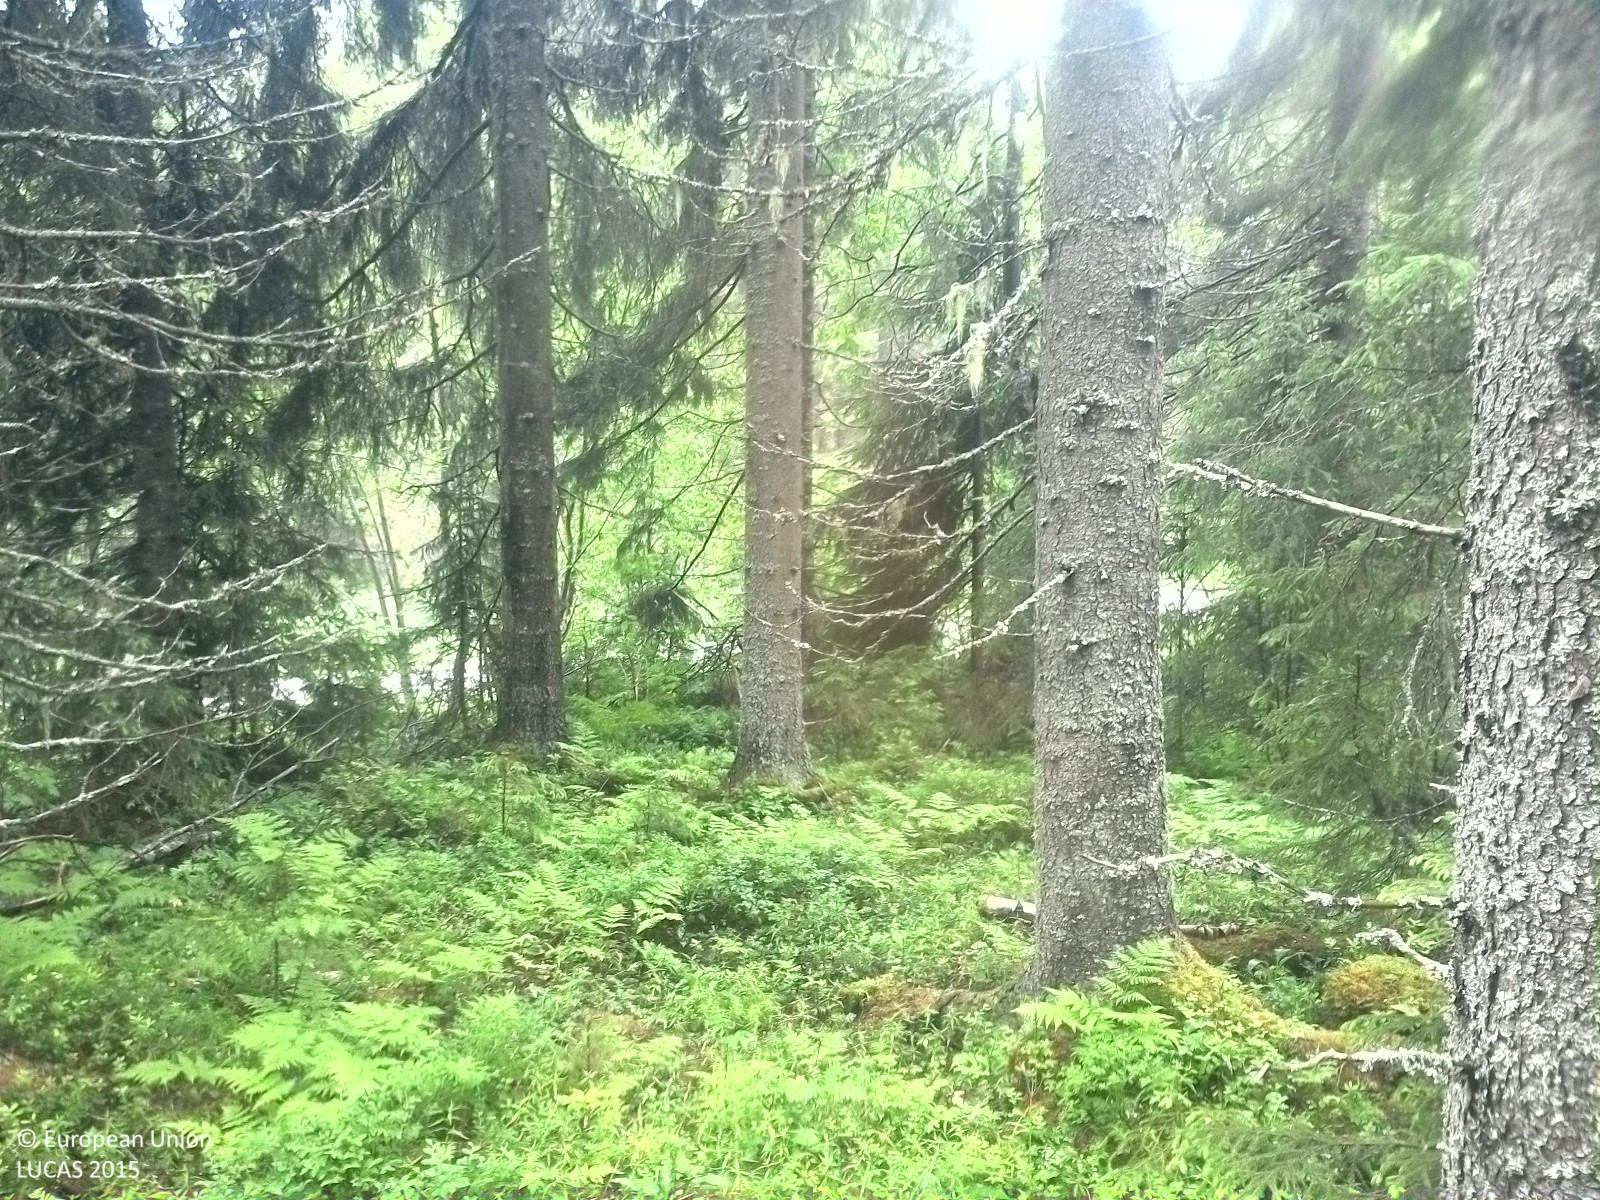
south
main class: Woodland
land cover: Spruce dominated mixed woodland
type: boreal forest
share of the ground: 50 - 75 %
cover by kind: coniferous forest trees 40 %, herbaceous plants 30 %, broadleaved forest trees 20 %, lichens and mosses 10 %
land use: Forestry
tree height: > 5 m
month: July
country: SE
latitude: 62.4756
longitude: 16.8265
